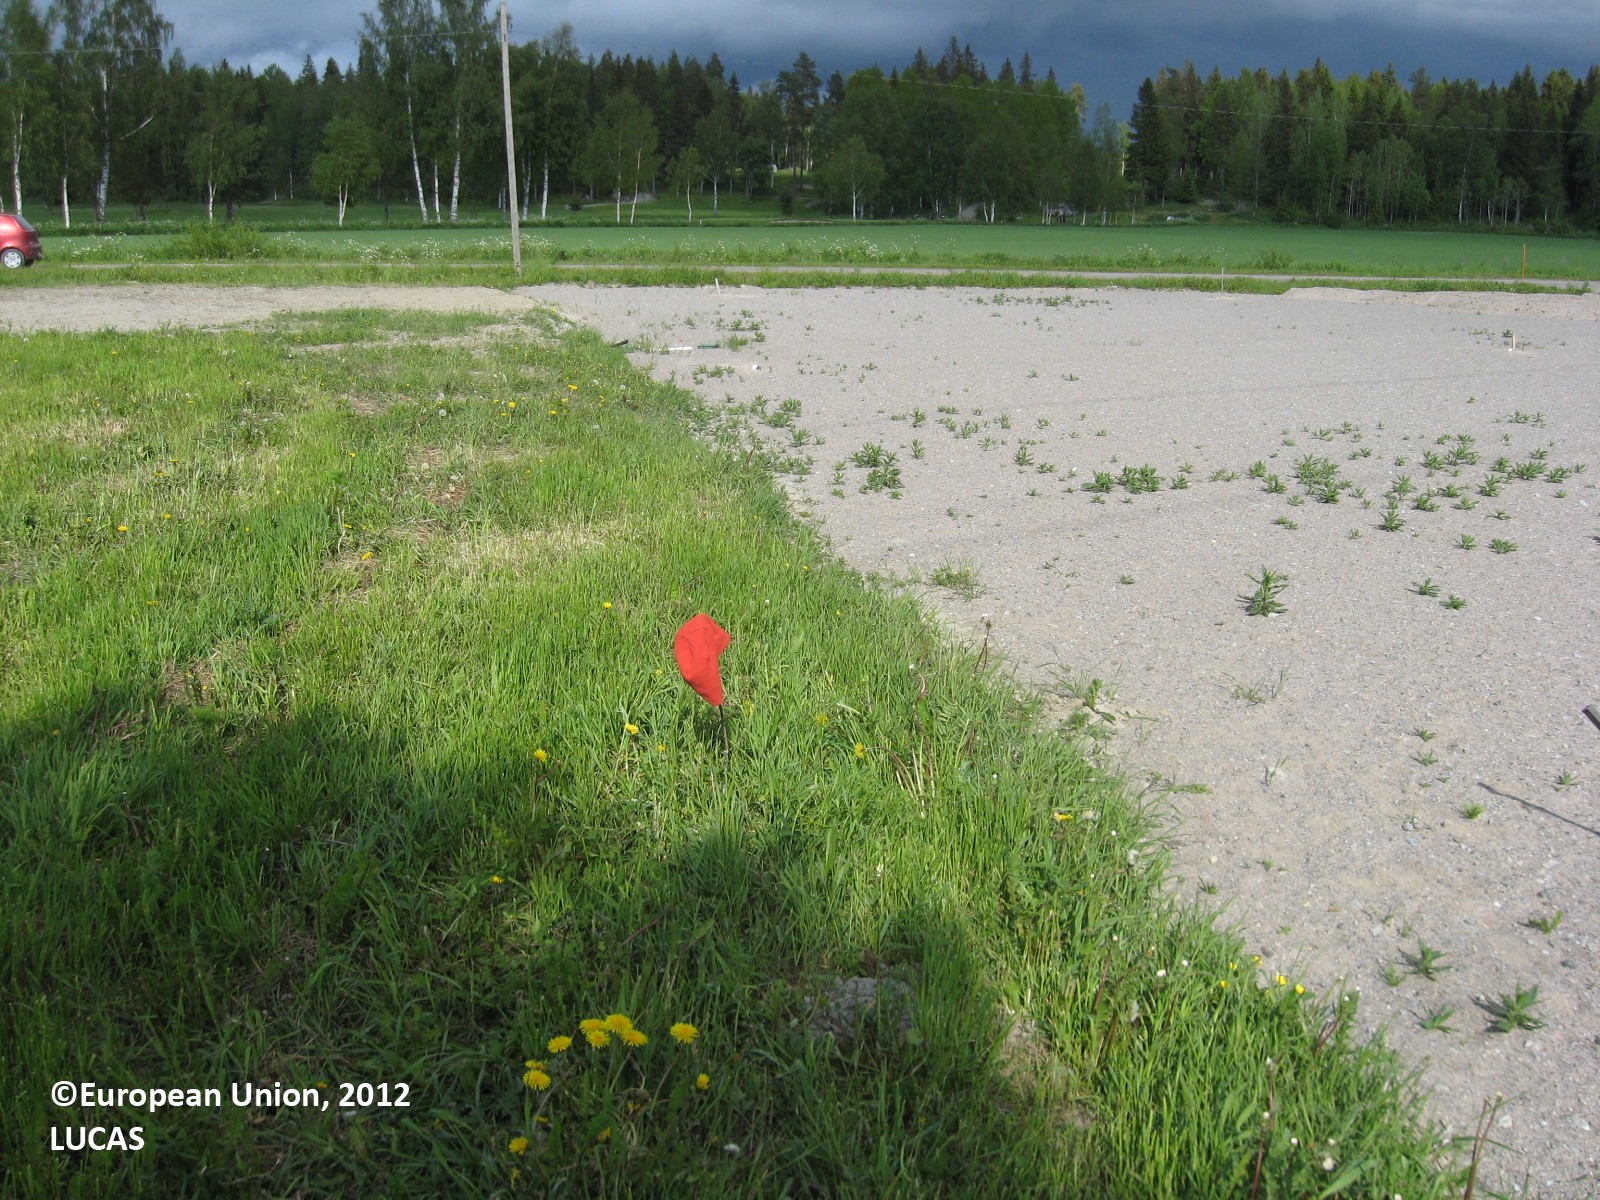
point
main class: Grassland
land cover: Grassland without tree/shrub cover
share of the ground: > 75 %
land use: Agriculture (excluding fallow land and kitchen gardens)
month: June
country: FI
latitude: 63.0830
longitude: 21.7432
